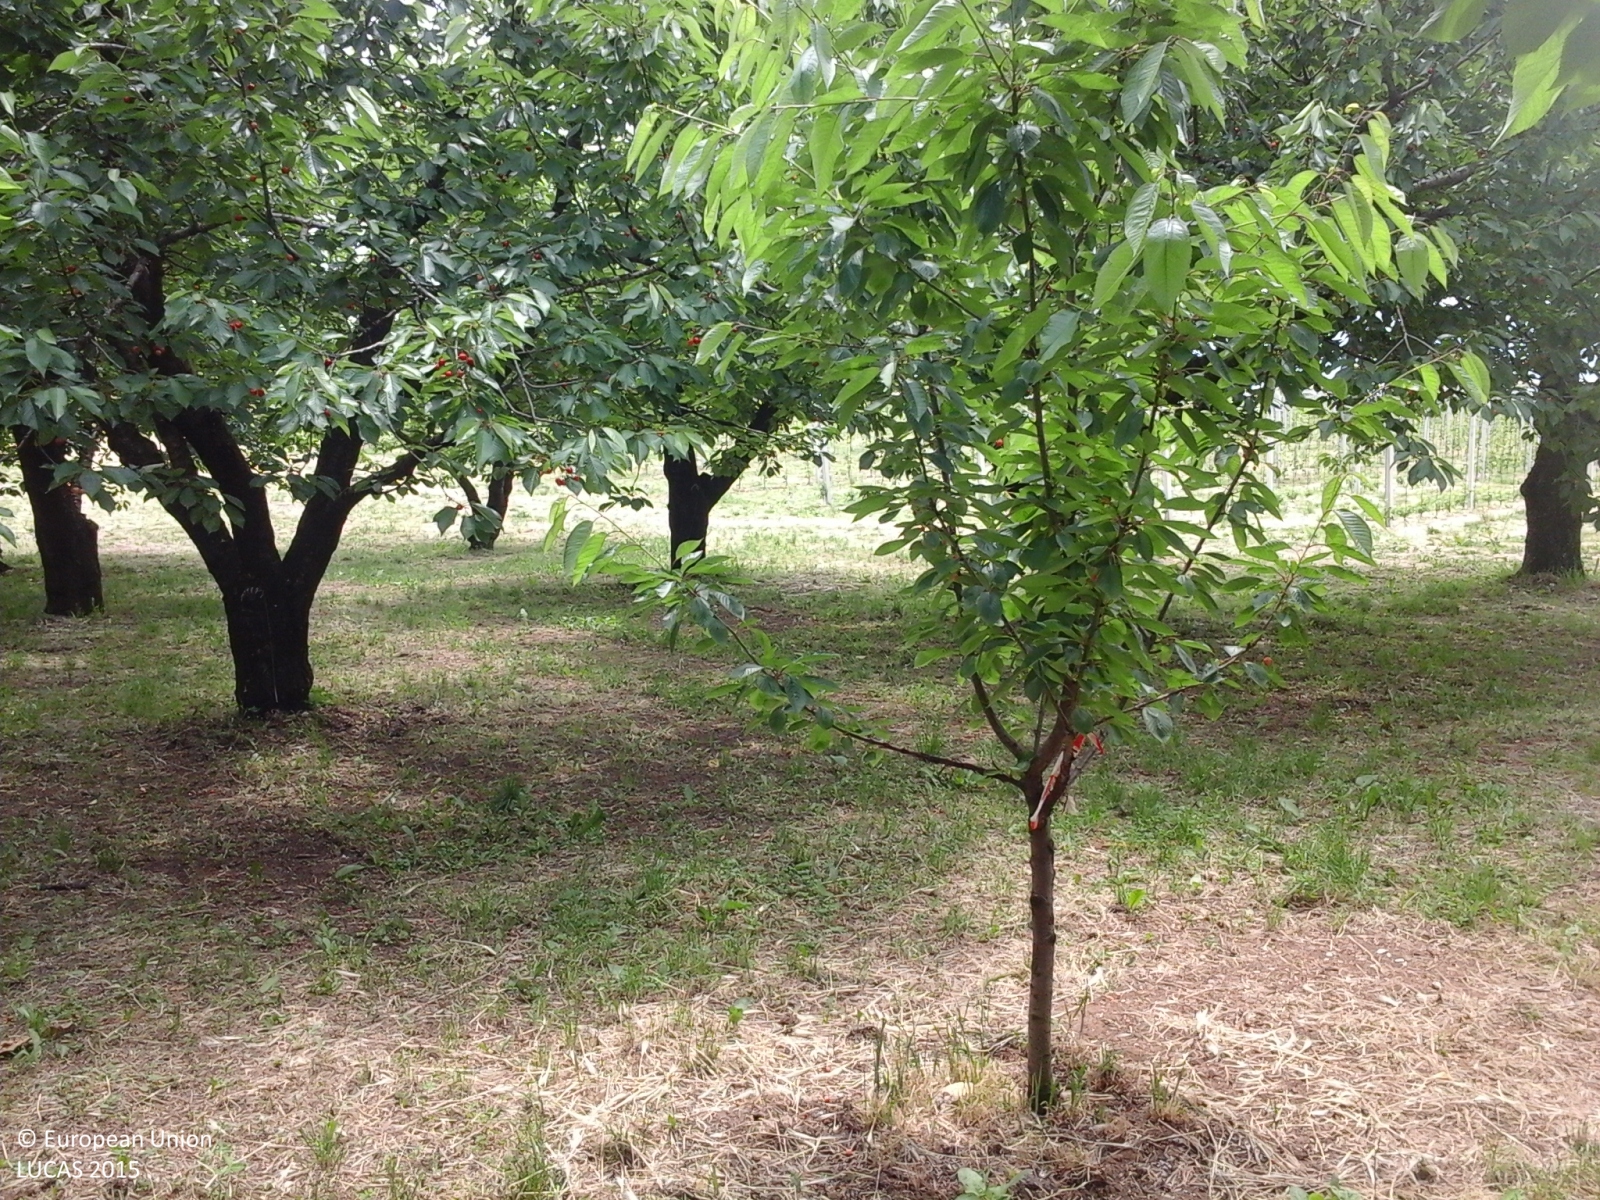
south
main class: Cropland
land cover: Cherry fruit
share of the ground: > 75 %
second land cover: Grassland without tree/shrub cover
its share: > 75 %
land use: Agriculture (excluding fallow land and kitchen gardens)
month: June
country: IT
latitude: 45.5724
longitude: 10.9339
